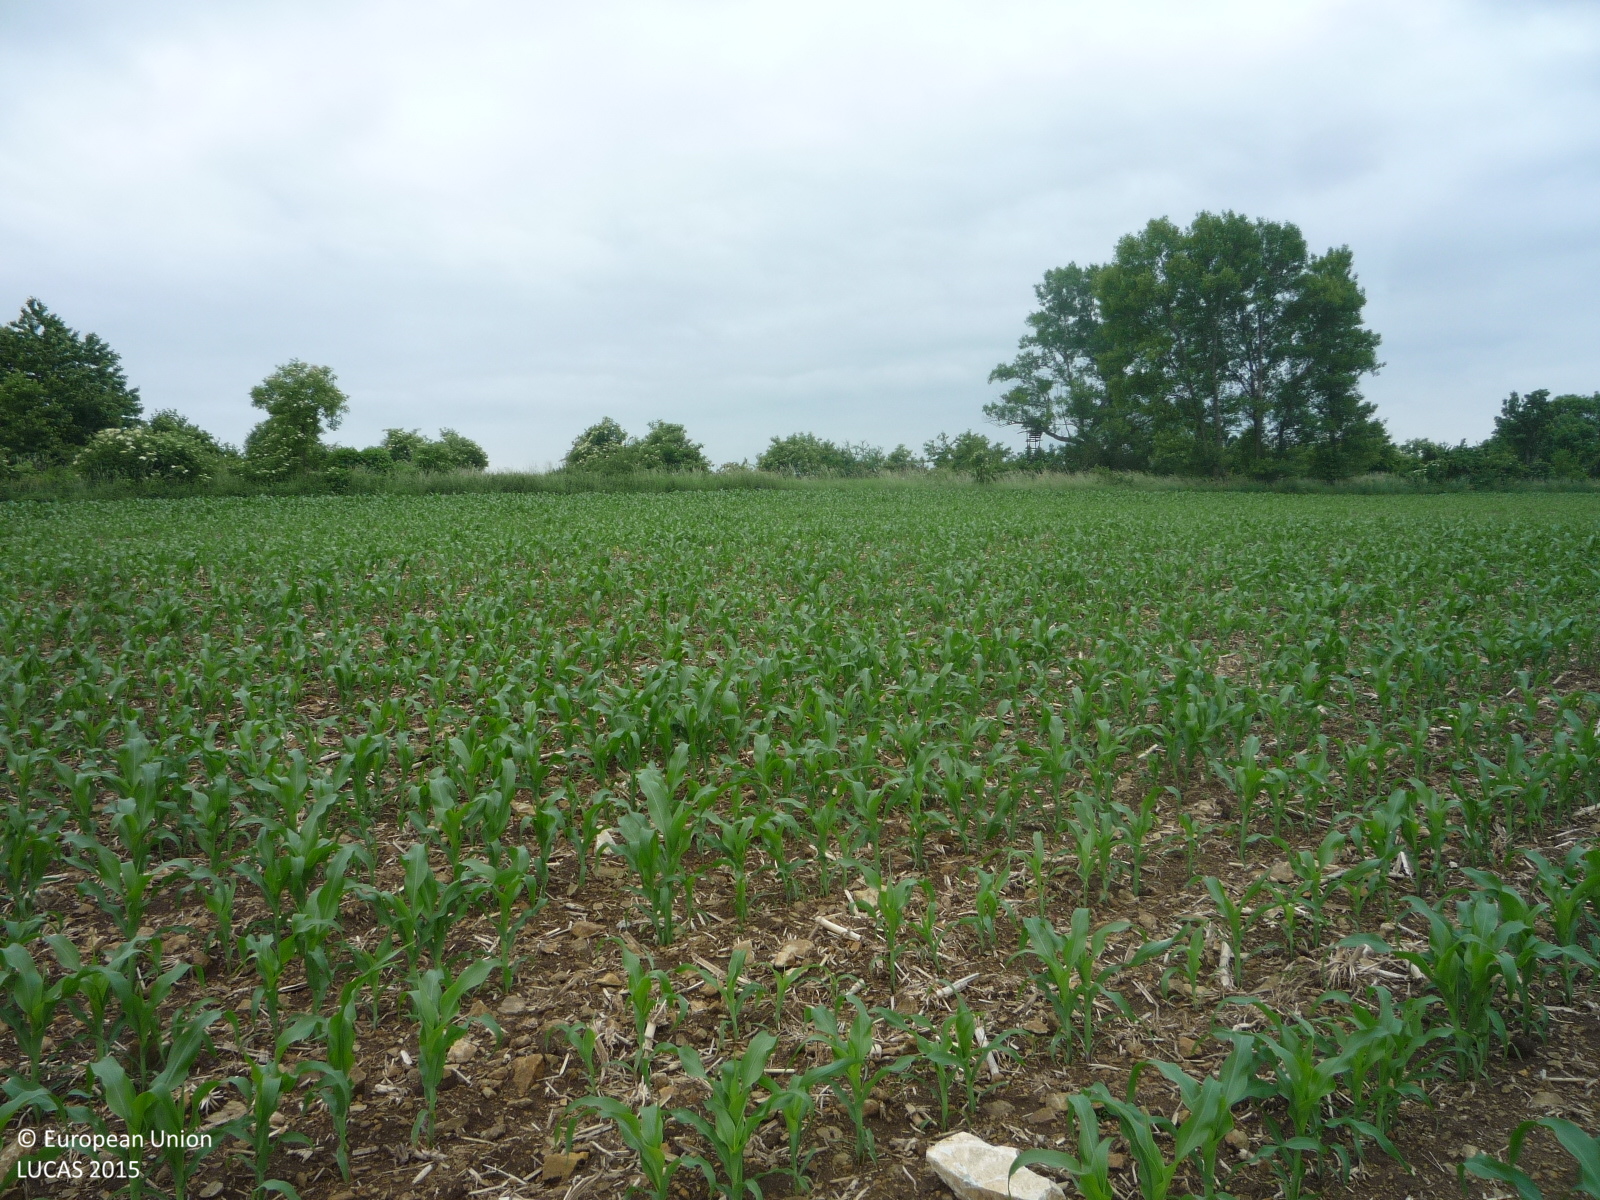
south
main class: Cropland
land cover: Maize
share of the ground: 25 - 50 %
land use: Agriculture (excluding fallow land and kitchen gardens)
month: June
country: CZ
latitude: 50.3348
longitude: 13.8643
